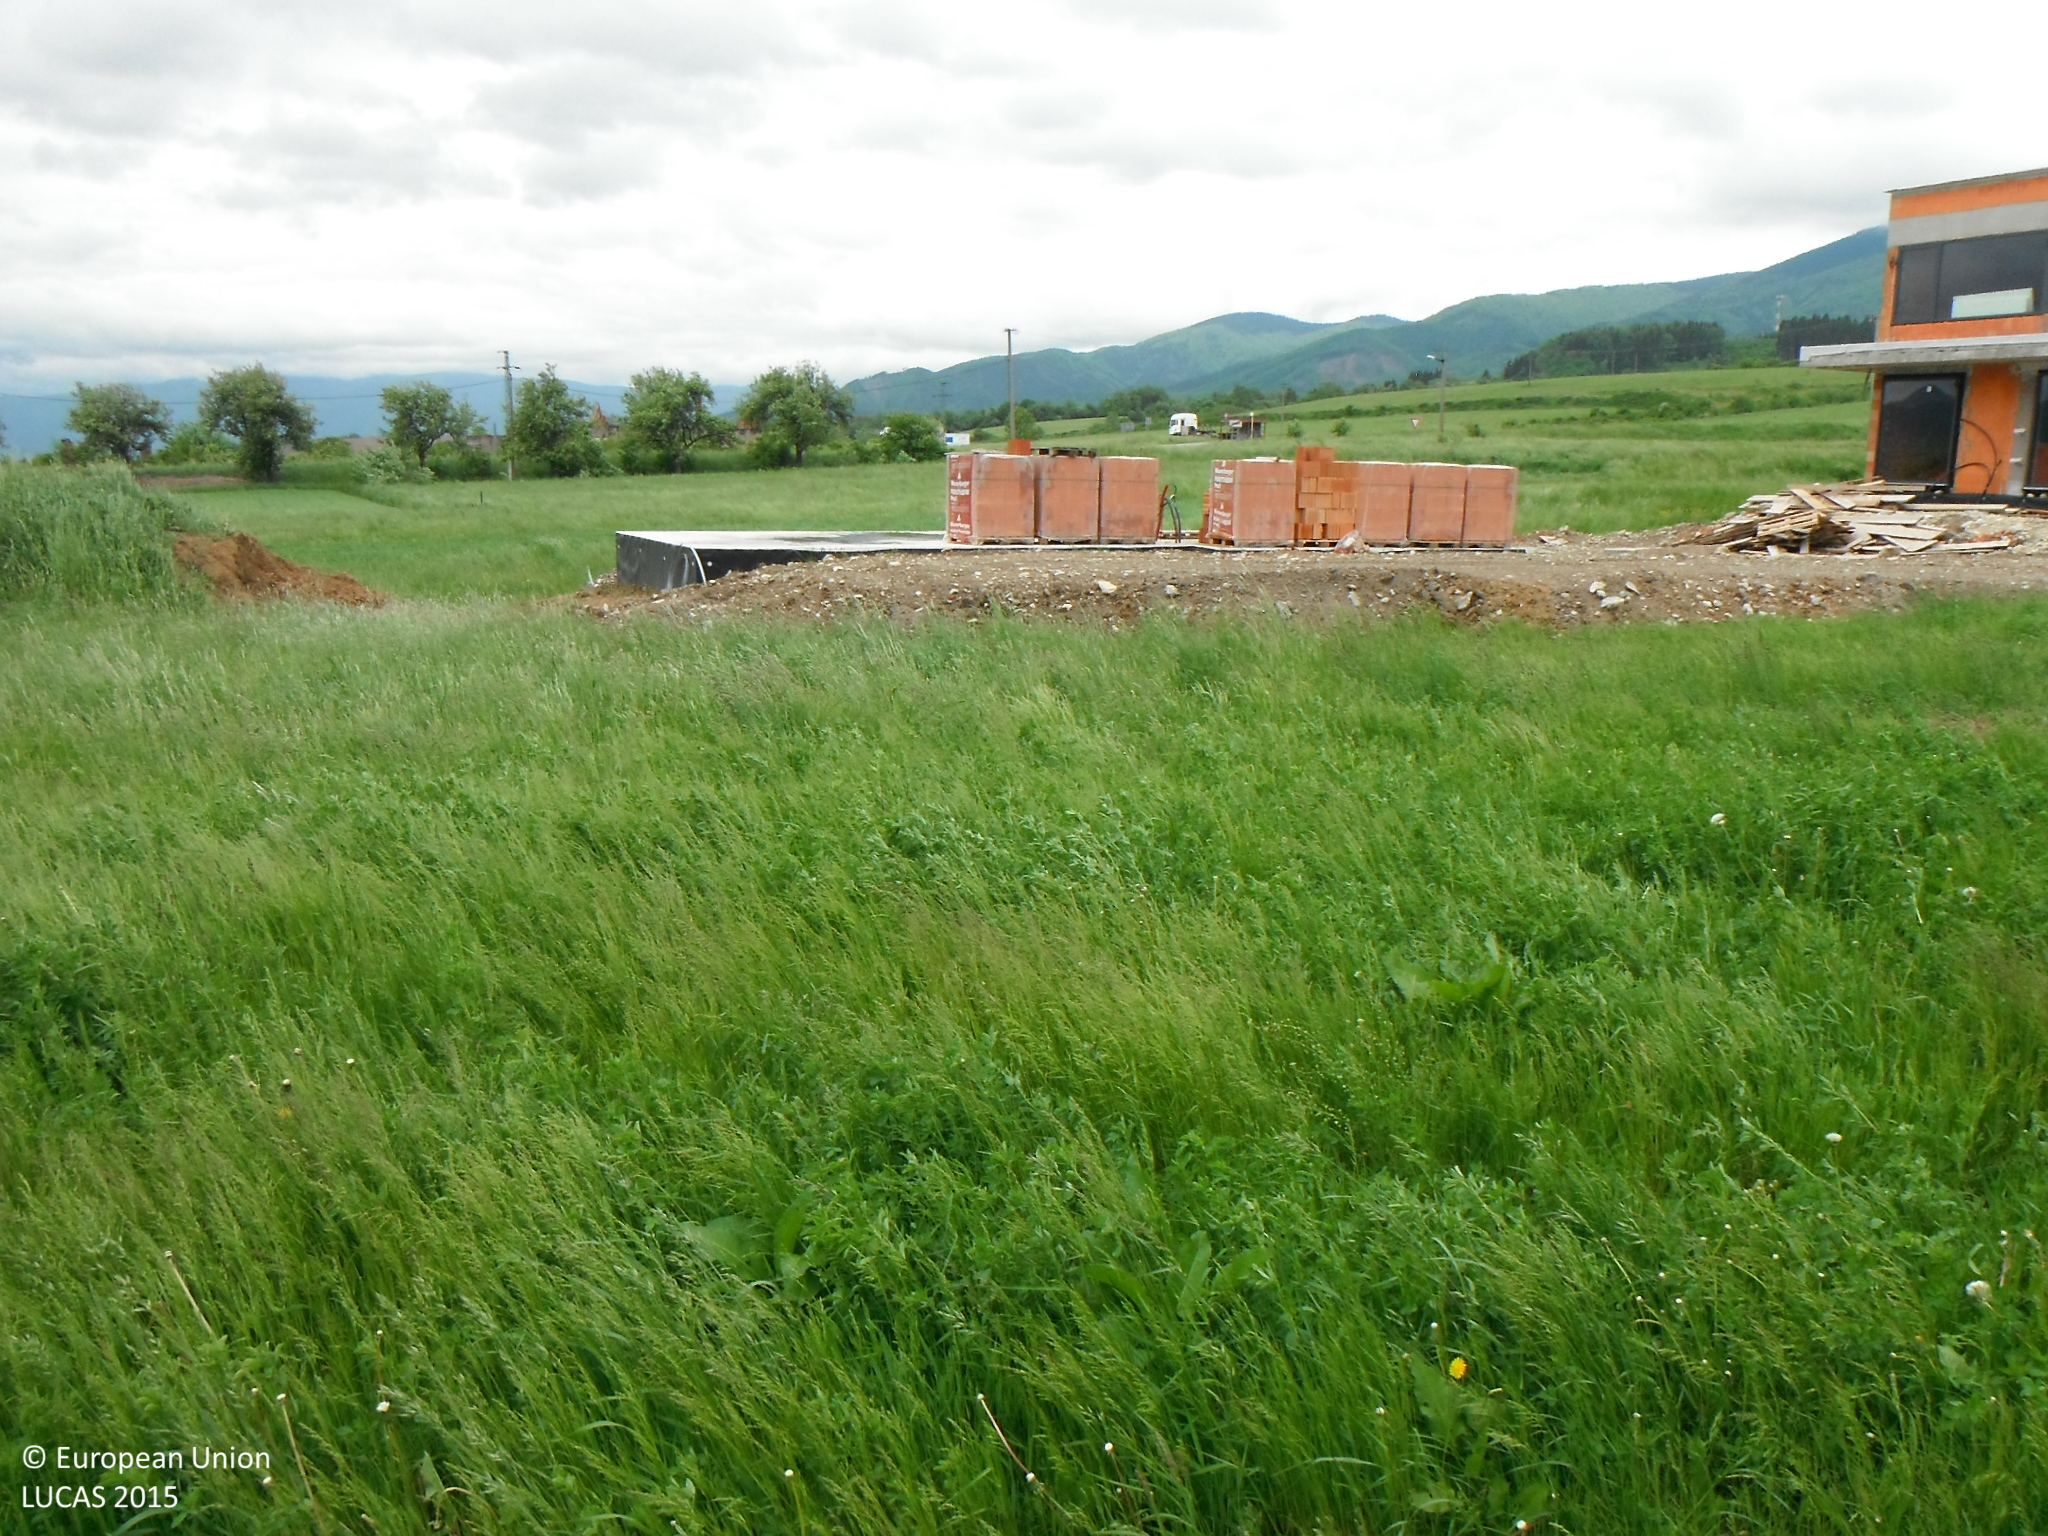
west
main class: Grassland
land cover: Grassland without tree/shrub cover
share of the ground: > 75 %
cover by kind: herbaceous plants 100 %
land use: Residential
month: May
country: SK
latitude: 49.1334
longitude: 19.0819
